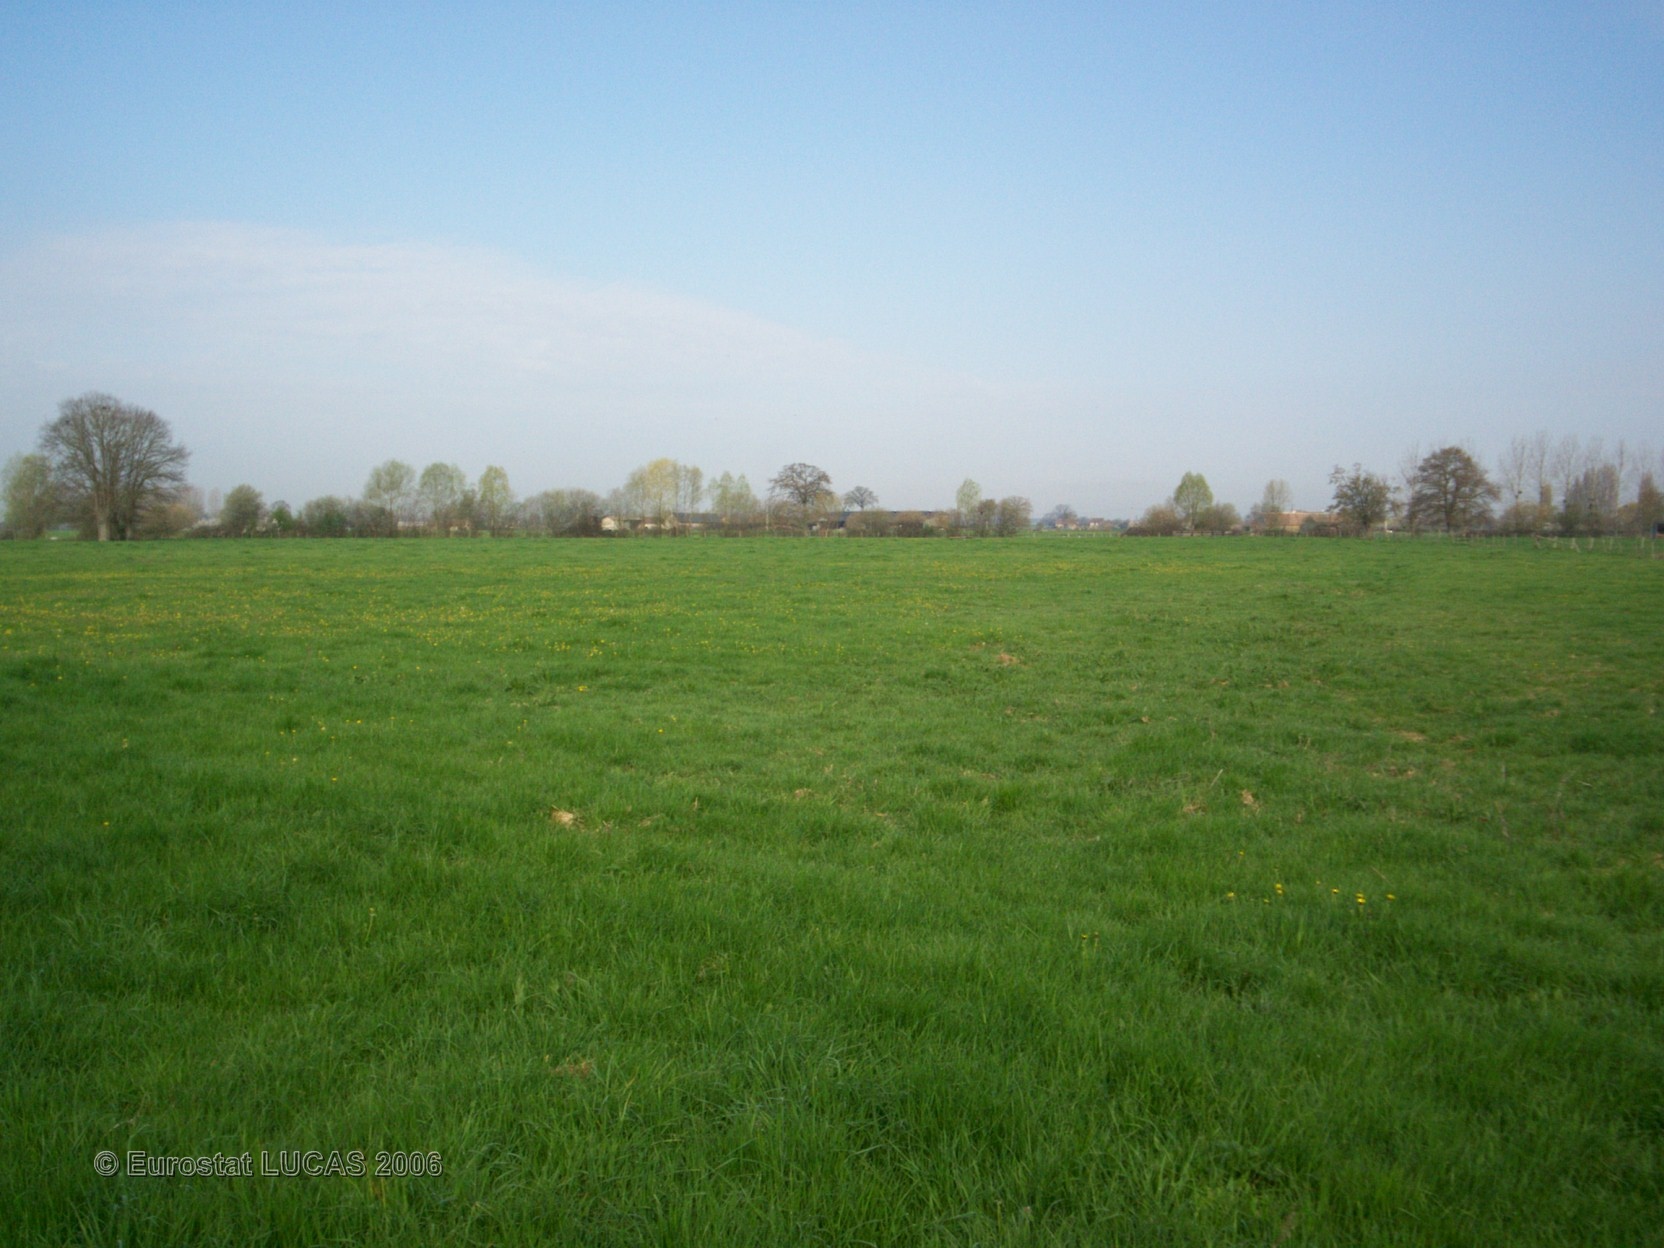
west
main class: Grassland
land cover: Grassland with sparse tree/shrub cover
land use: Agriculture (excluding fallow land and kitchen gardens)
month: April
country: FR
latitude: 48.1889
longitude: 0.2482
